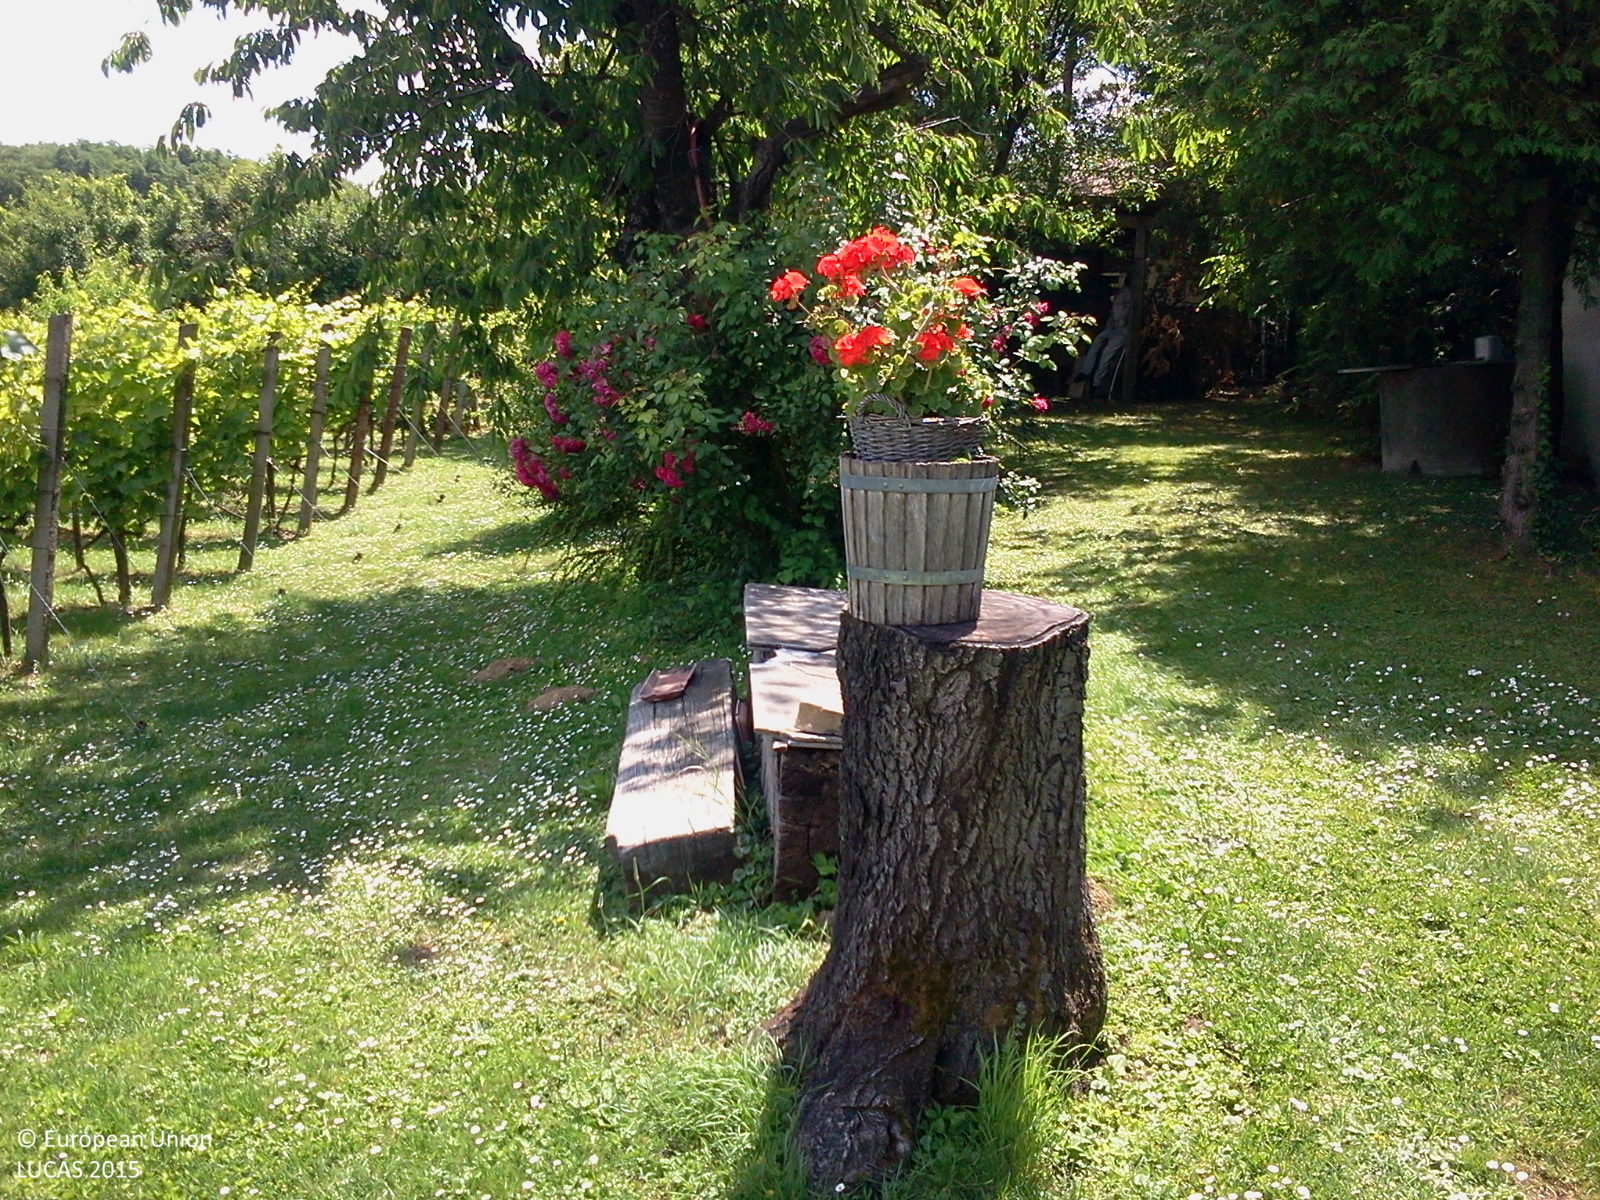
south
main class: Grassland
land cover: Grassland without tree/shrub cover
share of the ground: > 75 %
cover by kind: herbaceous plants 100 %
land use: Agriculture (excluding fallow land and kitchen gardens)
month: June
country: HU
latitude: 46.8903
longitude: 17.1311
